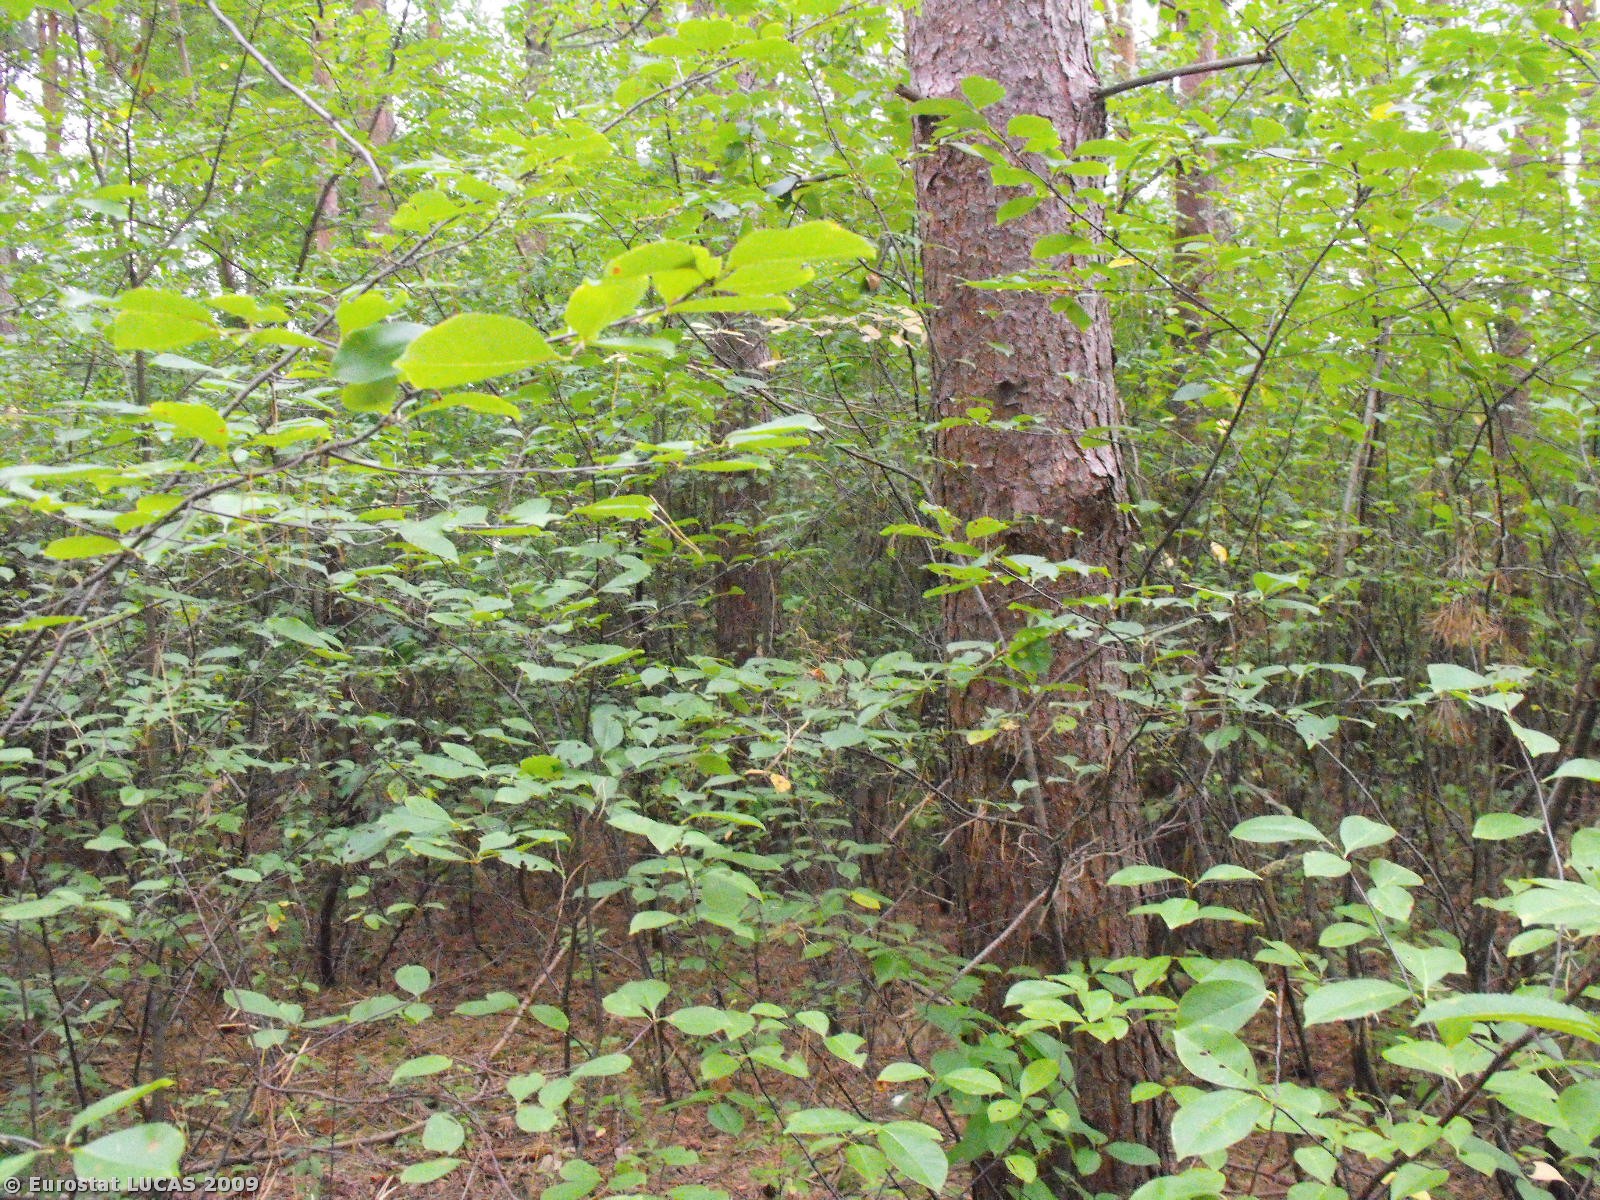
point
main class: Woodland
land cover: Mixed woodland
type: hemiboreal forest and nemoral coniferous forest and mixed broadleaved-coniferous forest
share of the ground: 50 - 75 %
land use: Forestry
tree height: > 5 m
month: September
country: PL
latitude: 53.0536
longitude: 16.3771
